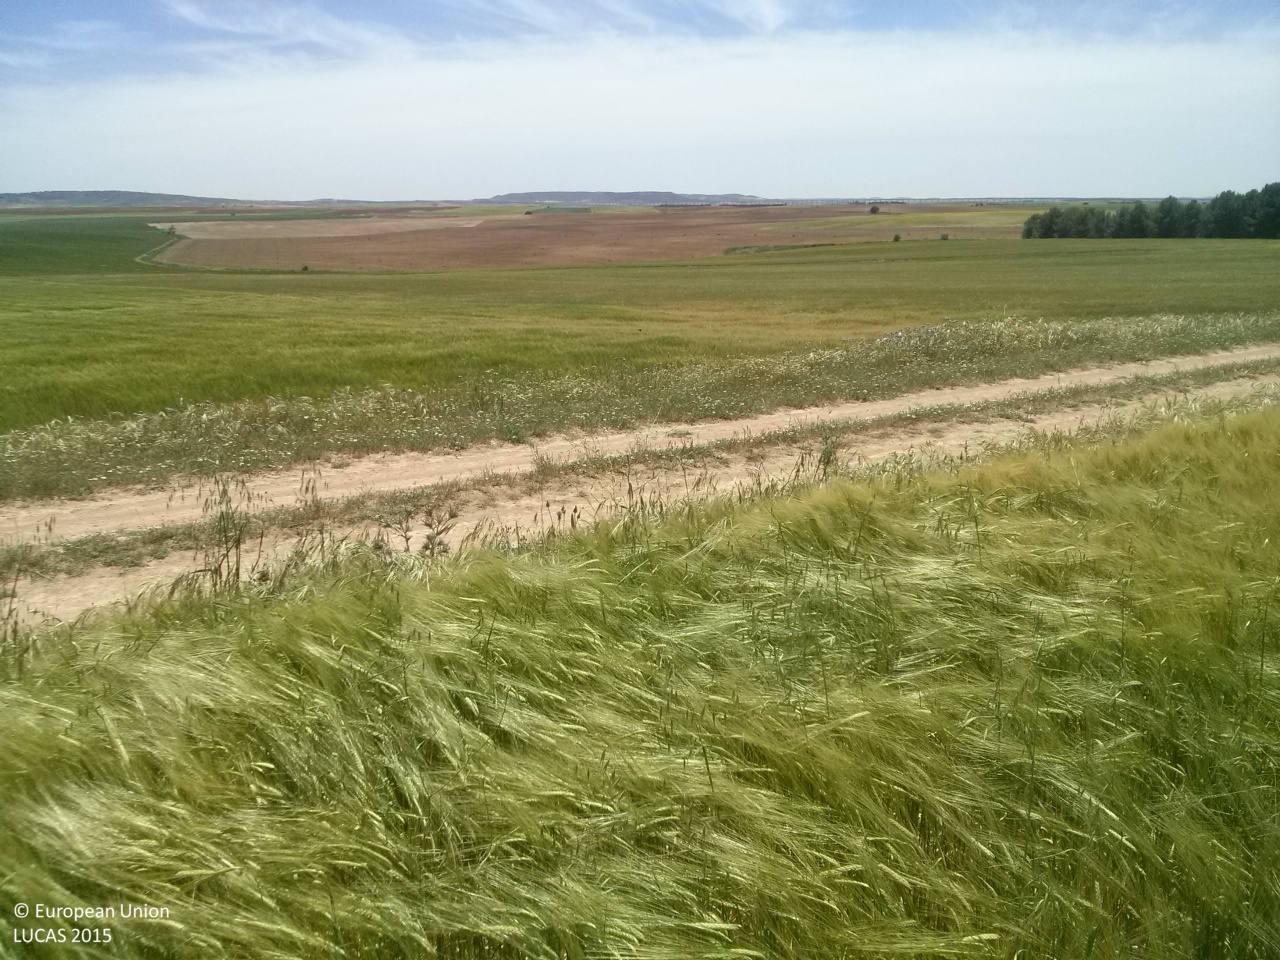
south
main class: Cropland
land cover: Barley
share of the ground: > 75 %
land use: Agriculture (excluding fallow land and kitchen gardens)
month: May
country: ES
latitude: 40.0075
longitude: -2.6837
